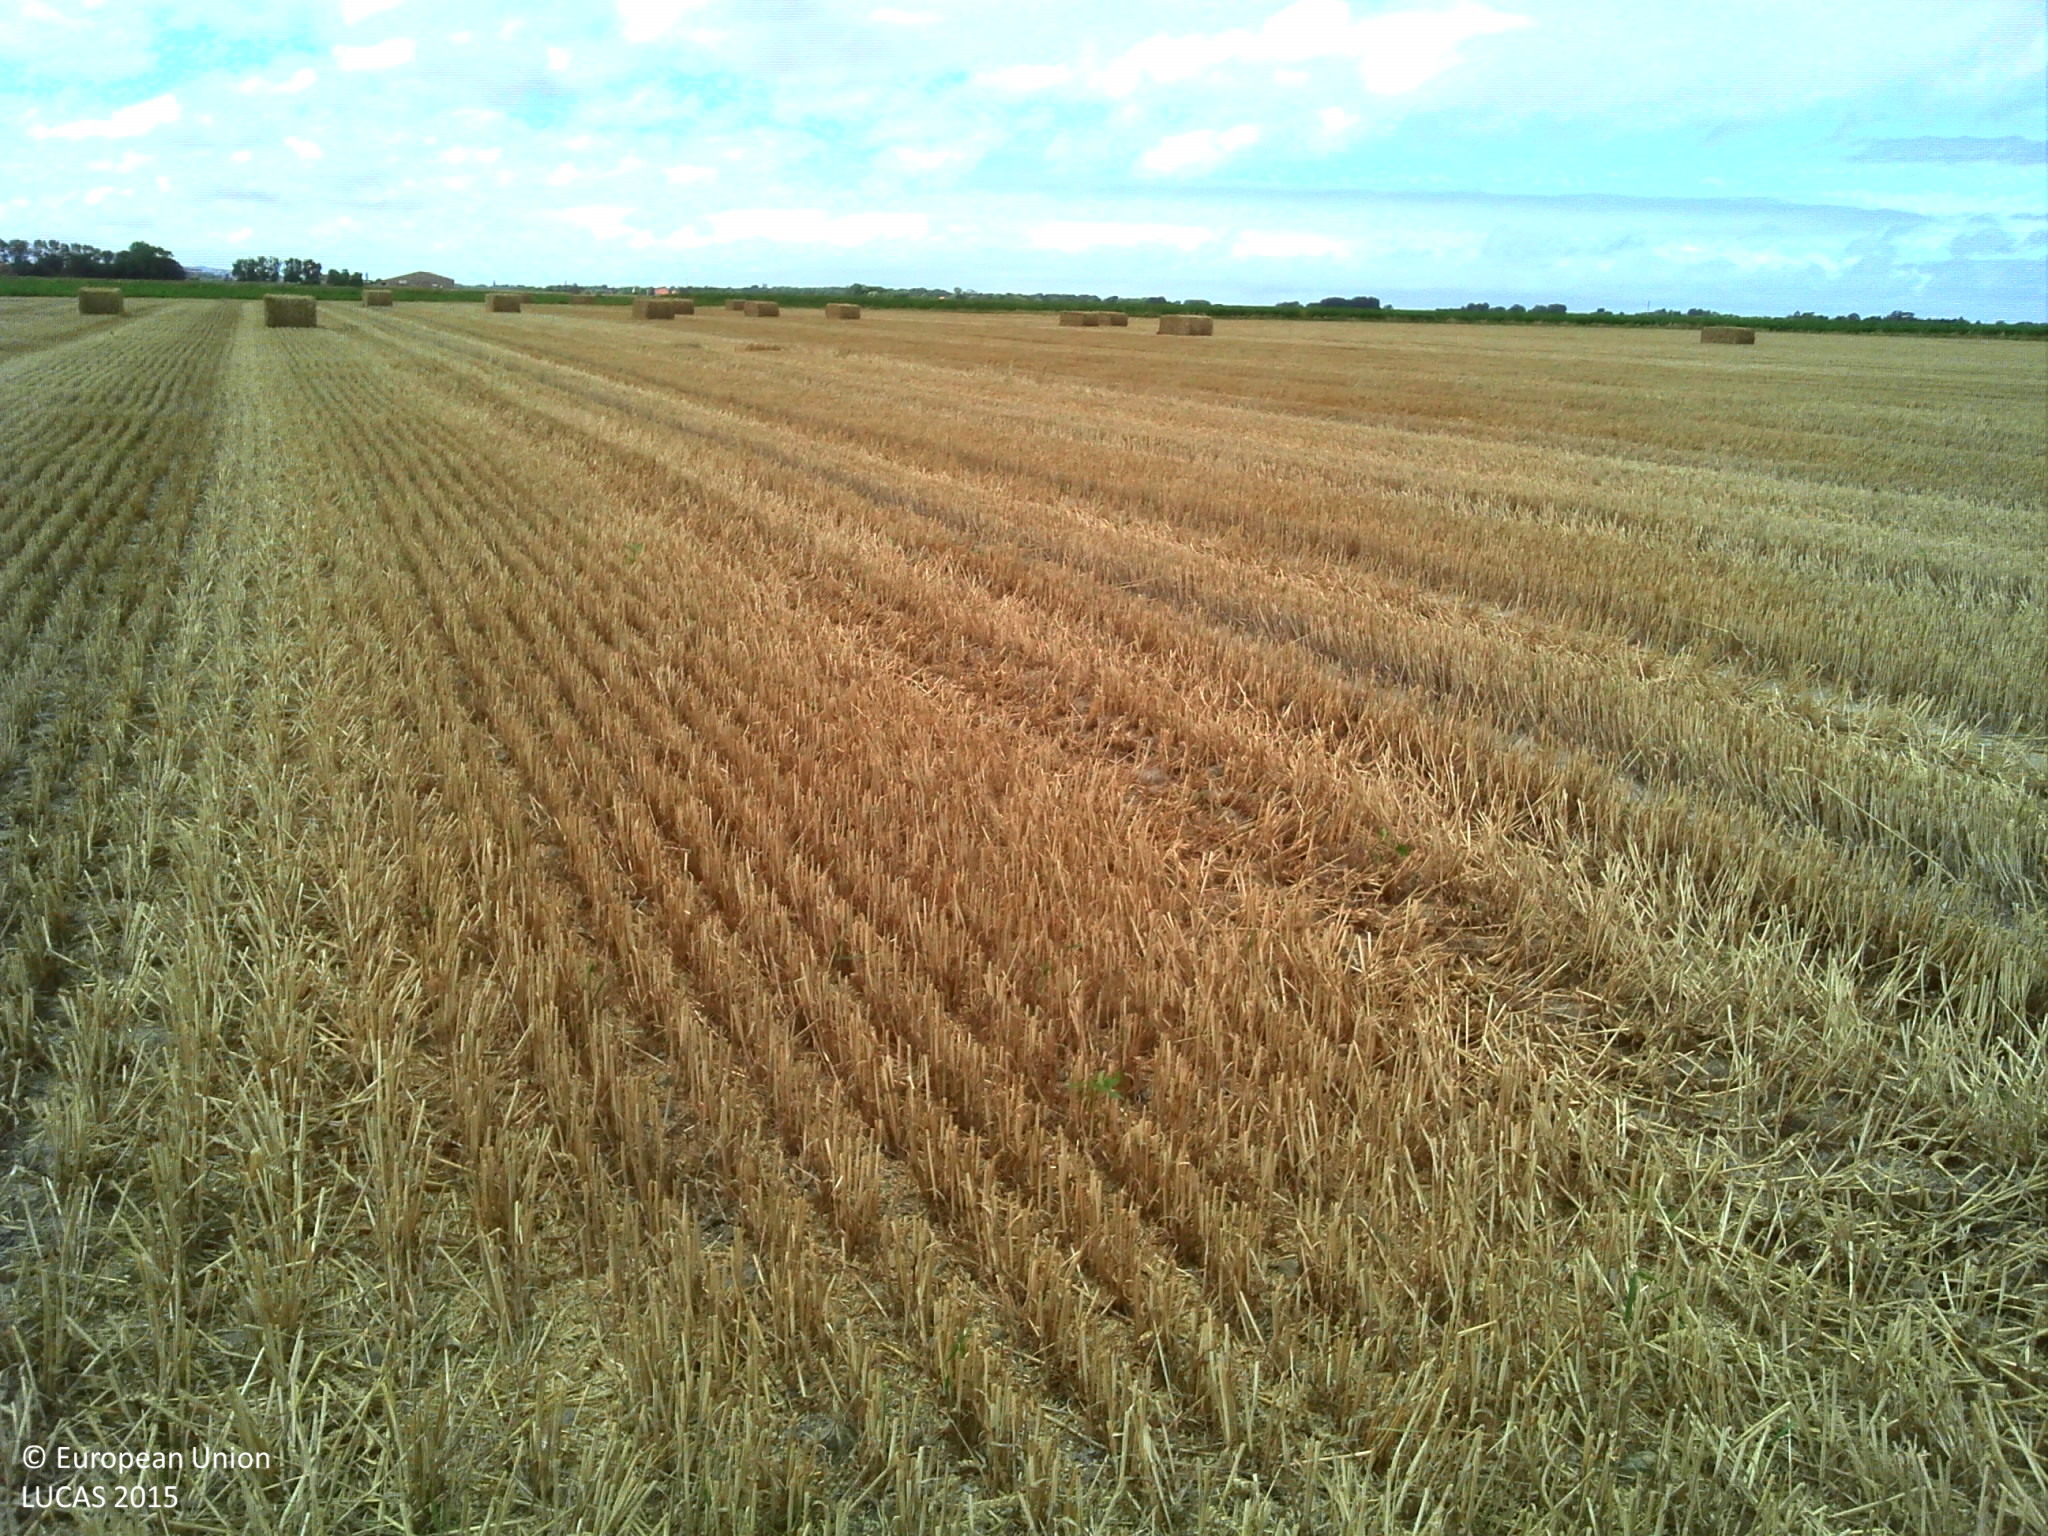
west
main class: Cropland
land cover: Common wheat
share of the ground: 50 - 75 %
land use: Agriculture (excluding fallow land and kitchen gardens)
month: August
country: FR
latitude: 50.9687
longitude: 1.9954
